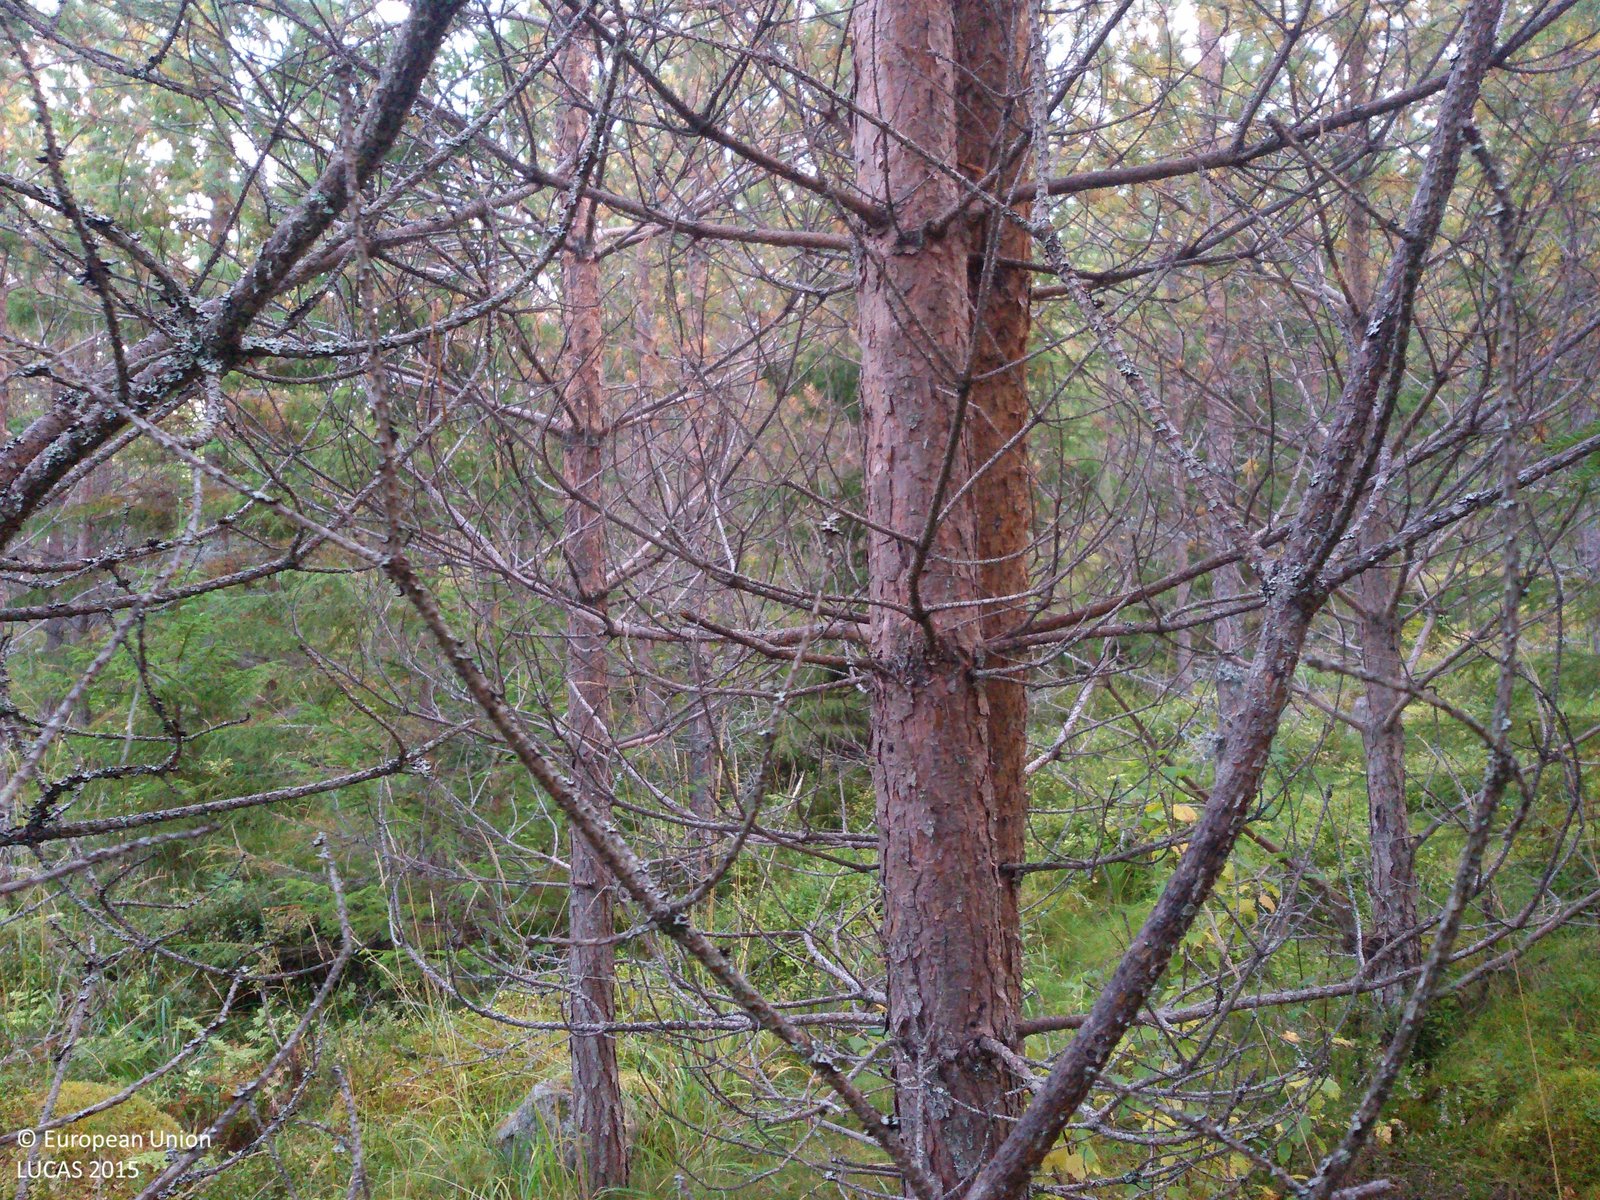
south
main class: Woodland
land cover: Pine dominated coniferous woodland
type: boreal forest
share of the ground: > 75 %
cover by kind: coniferous forest trees 80 %, shrubs 15 %, lichens and mosses 5 %
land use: Forestry
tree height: > 5 m
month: September
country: SE
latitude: 60.7158
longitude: 14.6975
